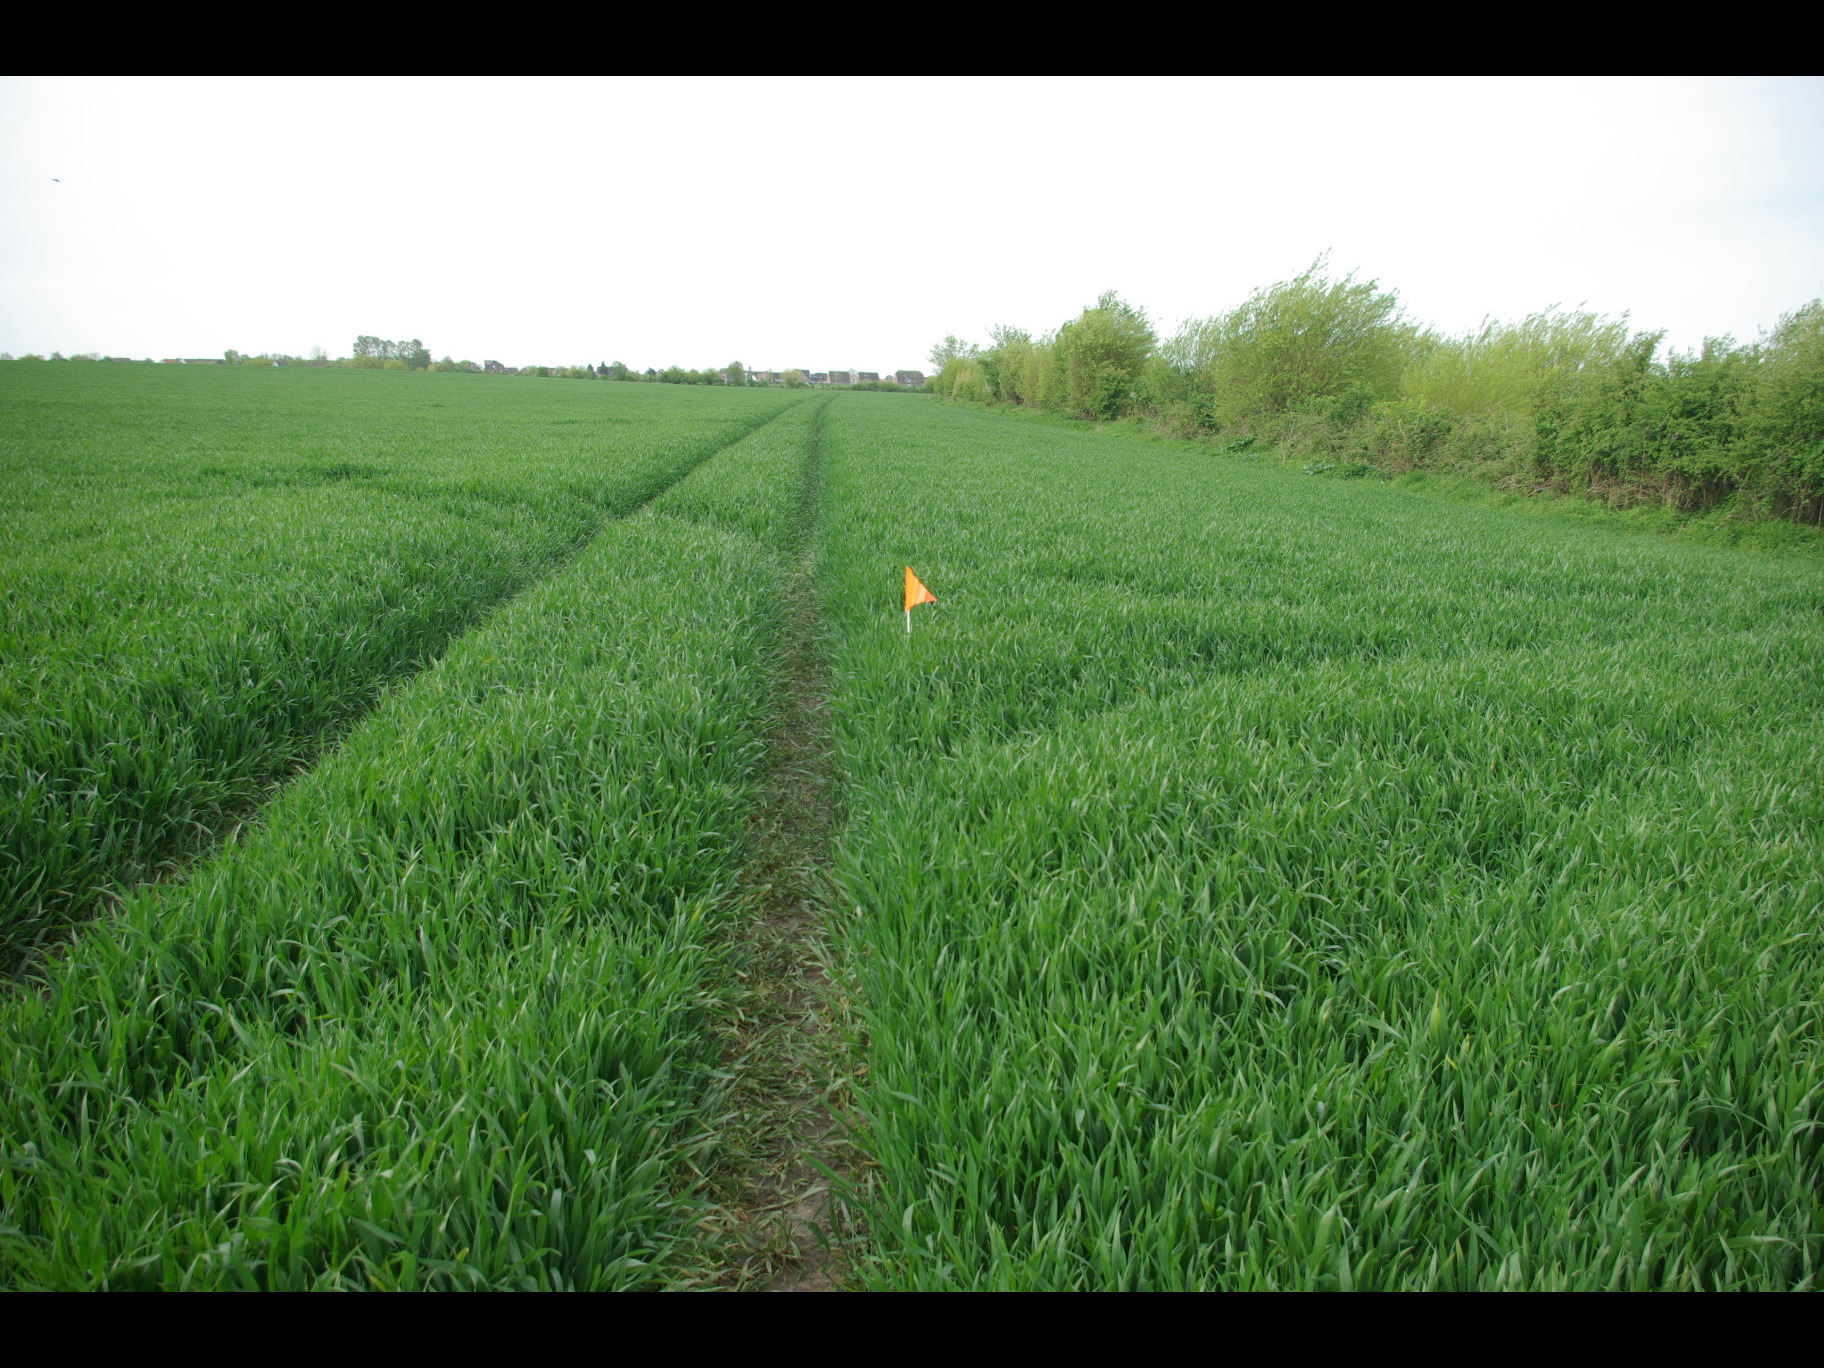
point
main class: Cropland
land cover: Common wheat
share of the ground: > 75 %
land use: Agriculture (excluding fallow land and kitchen gardens)
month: May
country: DE
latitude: 54.4569
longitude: 11.1562
